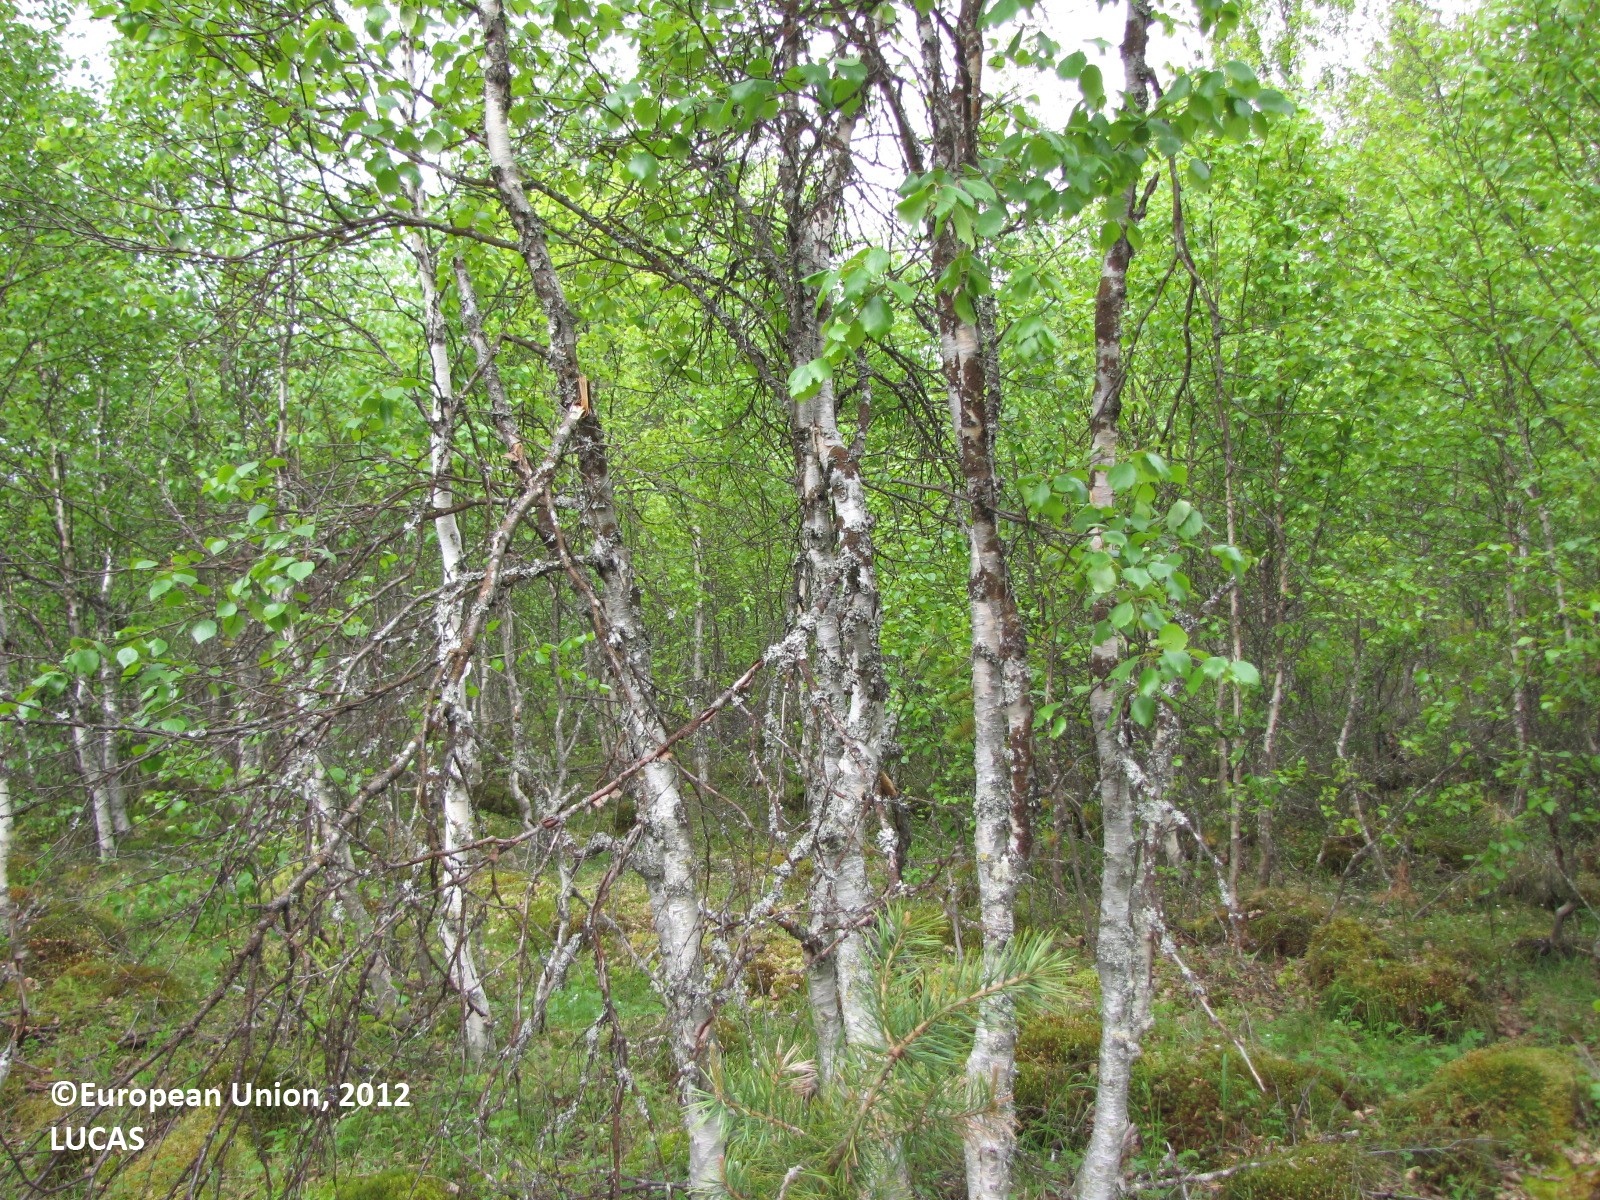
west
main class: Woodland
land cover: Broadleaved woodland
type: boreal forest
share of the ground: > 75 %
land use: Forestry
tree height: > 5 m
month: June
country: FI
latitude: 66.1492
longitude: 24.6573
